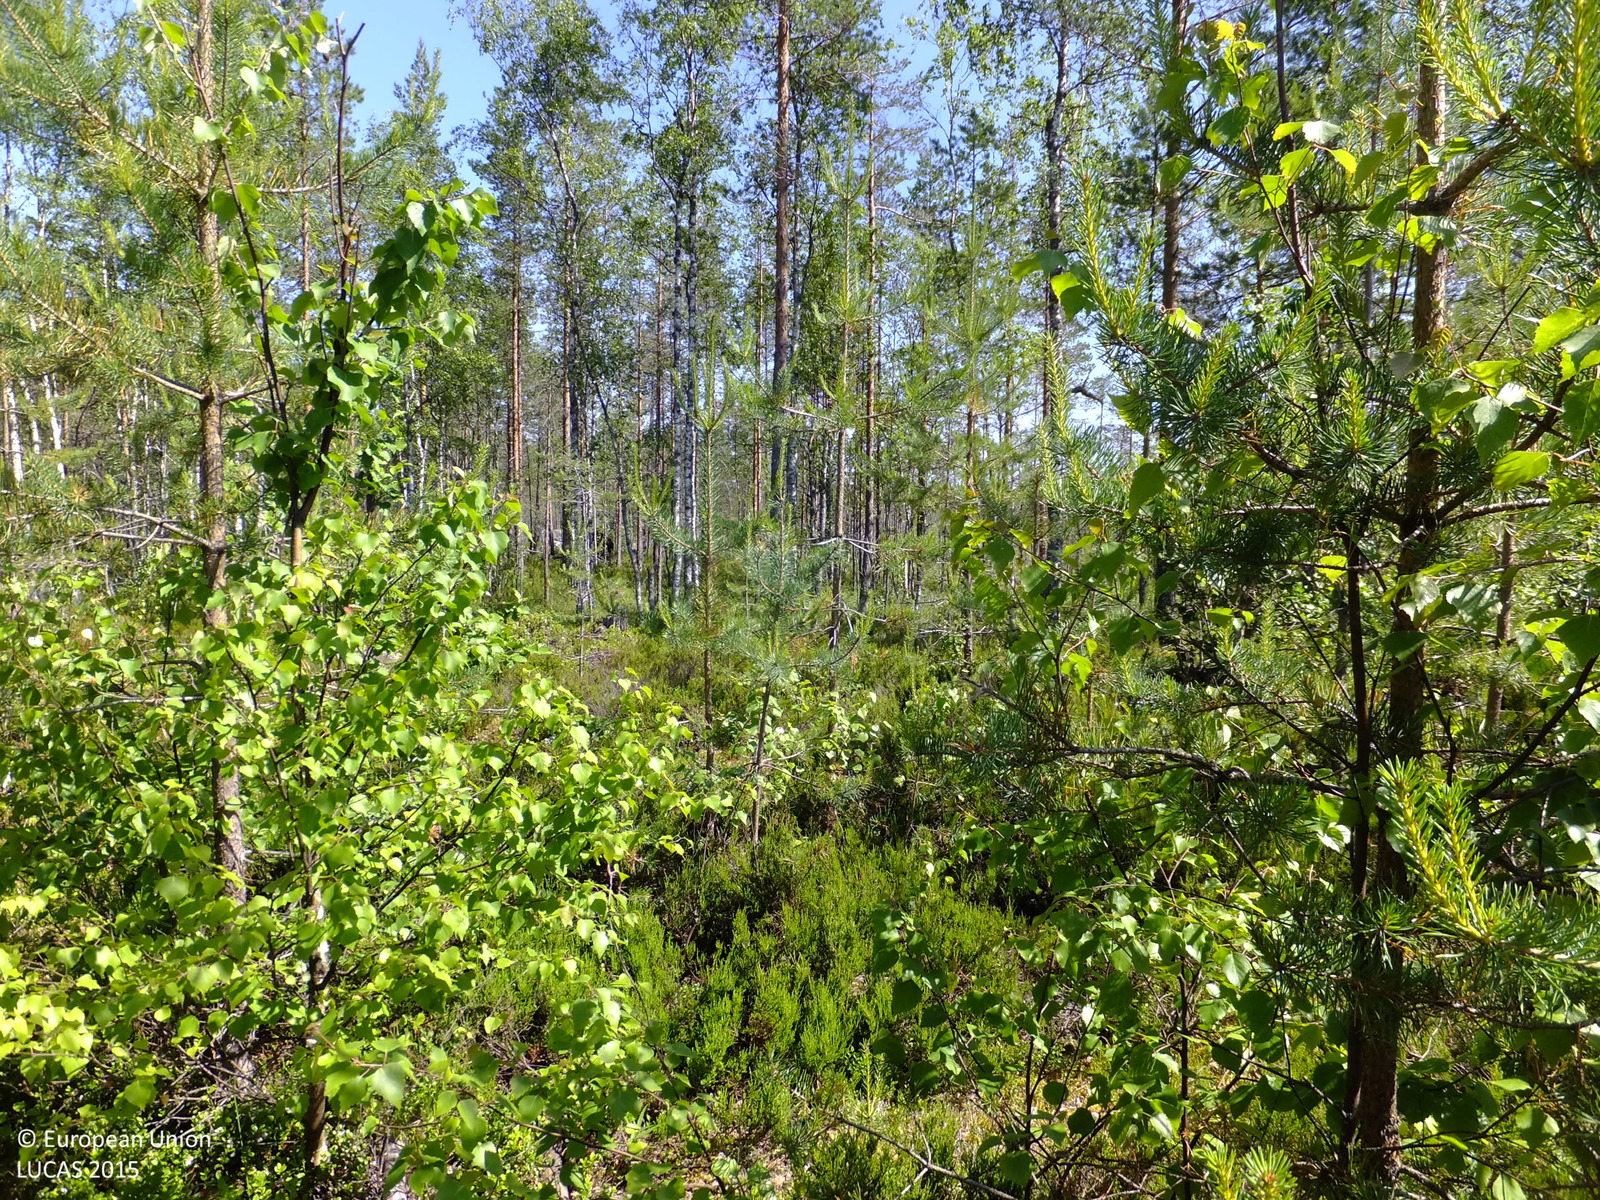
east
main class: Woodland
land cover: Pine dominated mixed woodland
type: boreal forest
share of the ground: 25 - 50 %
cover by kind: shrubs 40 %, coniferous forest trees 25 %, broadleaved forest trees 15 %, herbaceous plants 10 %, lichens and mosses 10 %
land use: Forestry
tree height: < 5 m
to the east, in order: Pine dominated mixed woodland; Rocks and stones; Pine dominated coniferous woodland; Ponds and wetlands
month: July
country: FI
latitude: 63.2744
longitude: 24.6141
